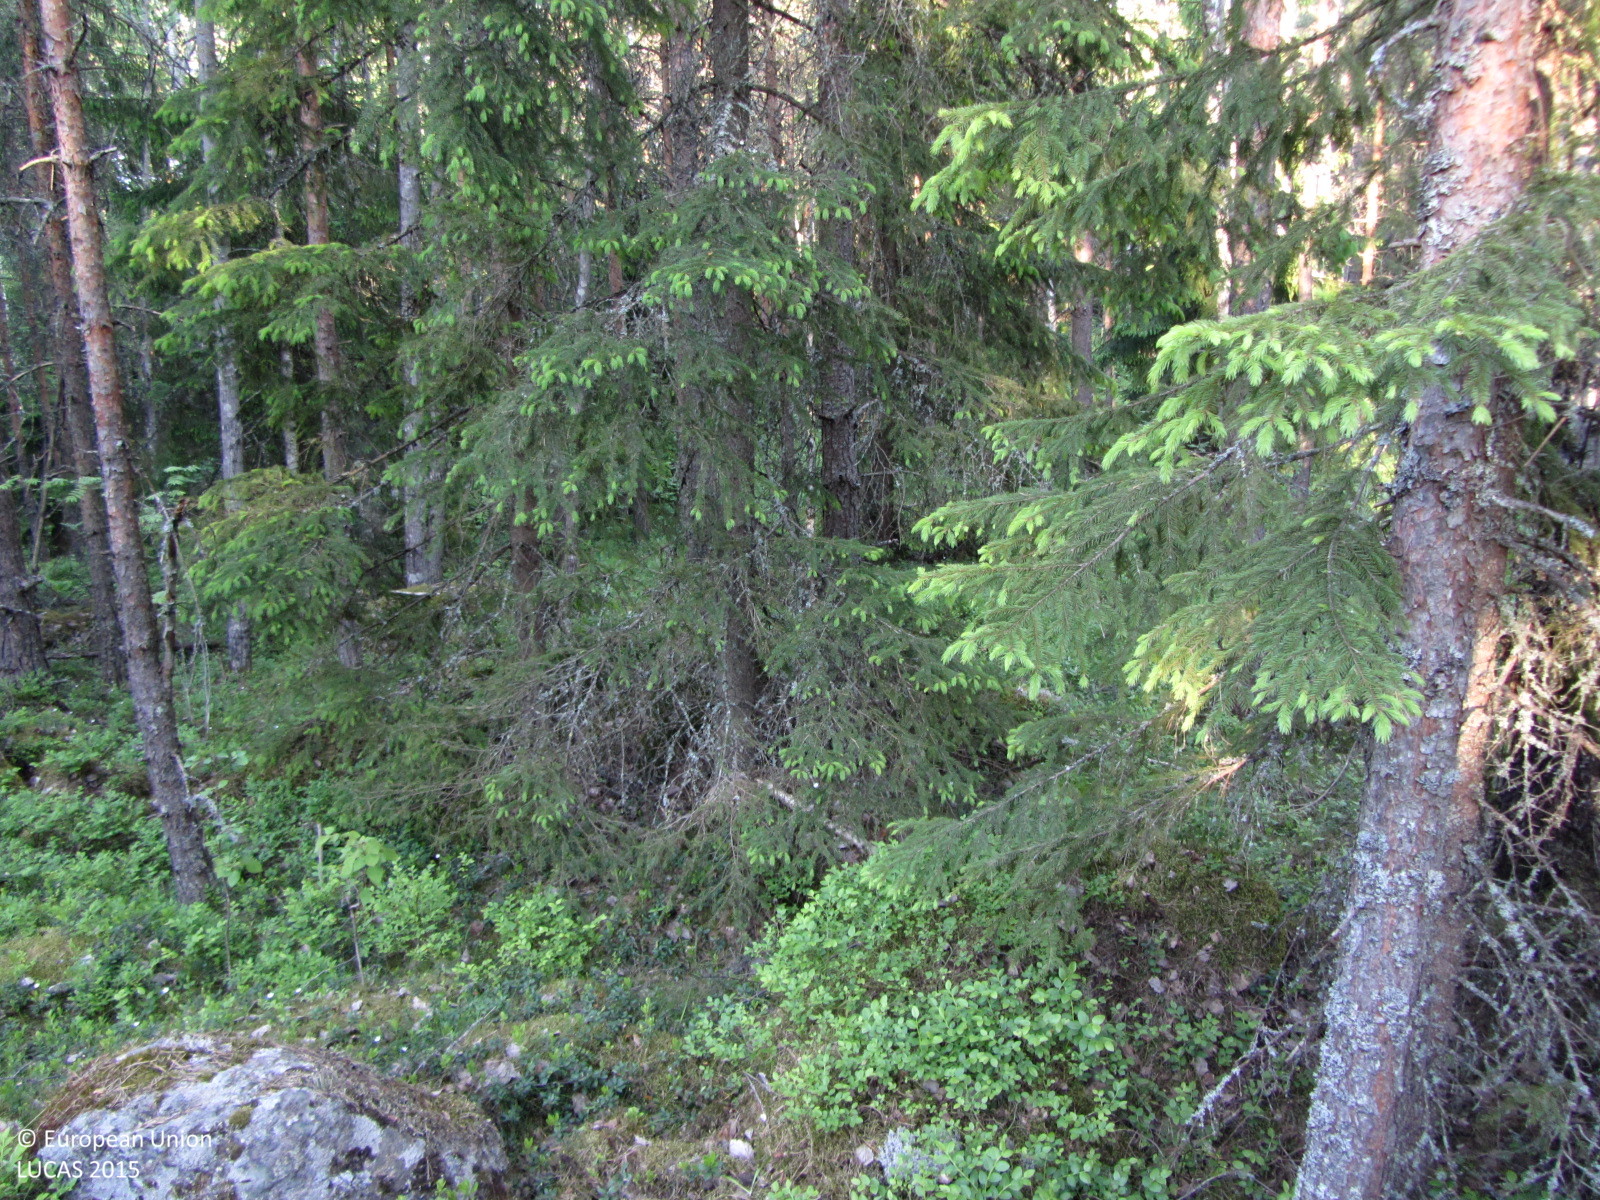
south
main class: Woodland
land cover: Other coniferous woodland
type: boreal forest
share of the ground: 50 - 75 %
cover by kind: coniferous forest trees 50 %, shrubs 30 %, broadleaved forest trees 10 %, lichens and mosses 10 %
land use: Forestry
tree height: > 5 m
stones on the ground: 10 - 25 %
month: June
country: FI
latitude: 60.3500
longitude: 24.2555
